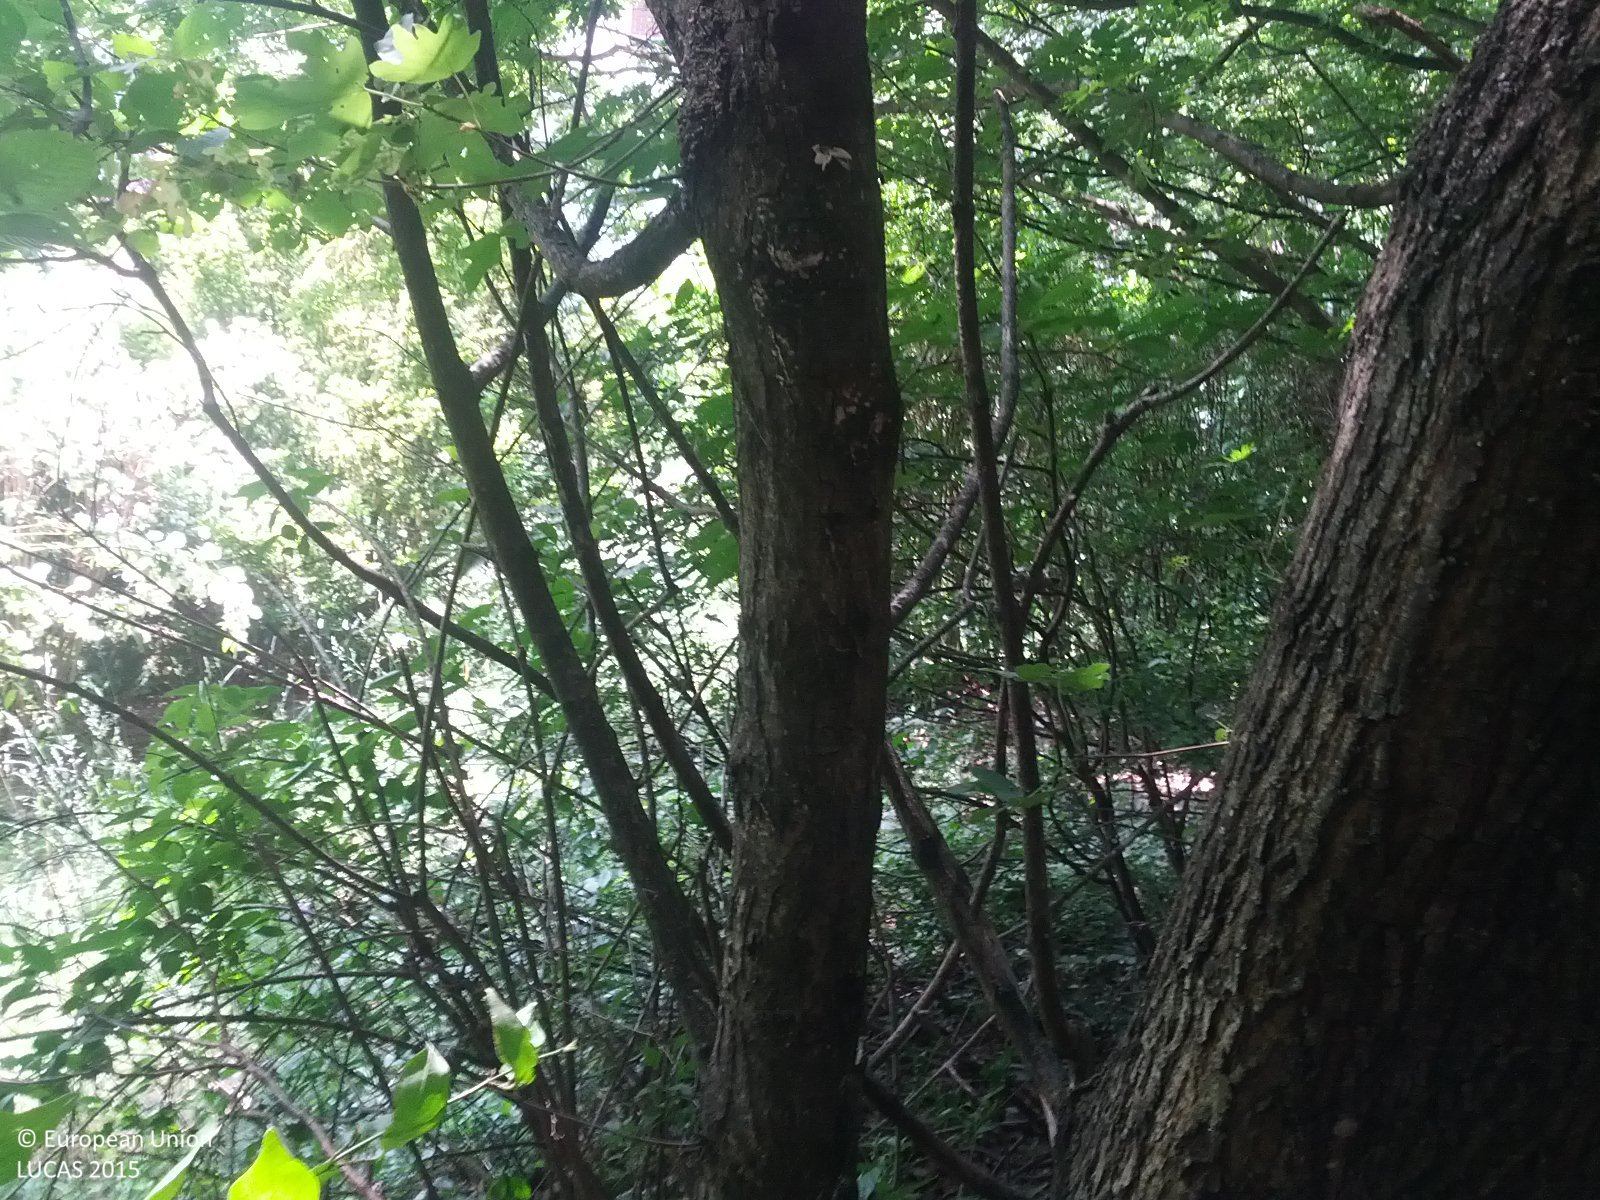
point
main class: Woodland
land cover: Broadleaved woodland
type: beech forest
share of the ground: > 75 %
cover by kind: broadleaved forest trees 100 %
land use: Forestry
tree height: > 5 m
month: June
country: AT
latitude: 48.1617
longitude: 16.1213
